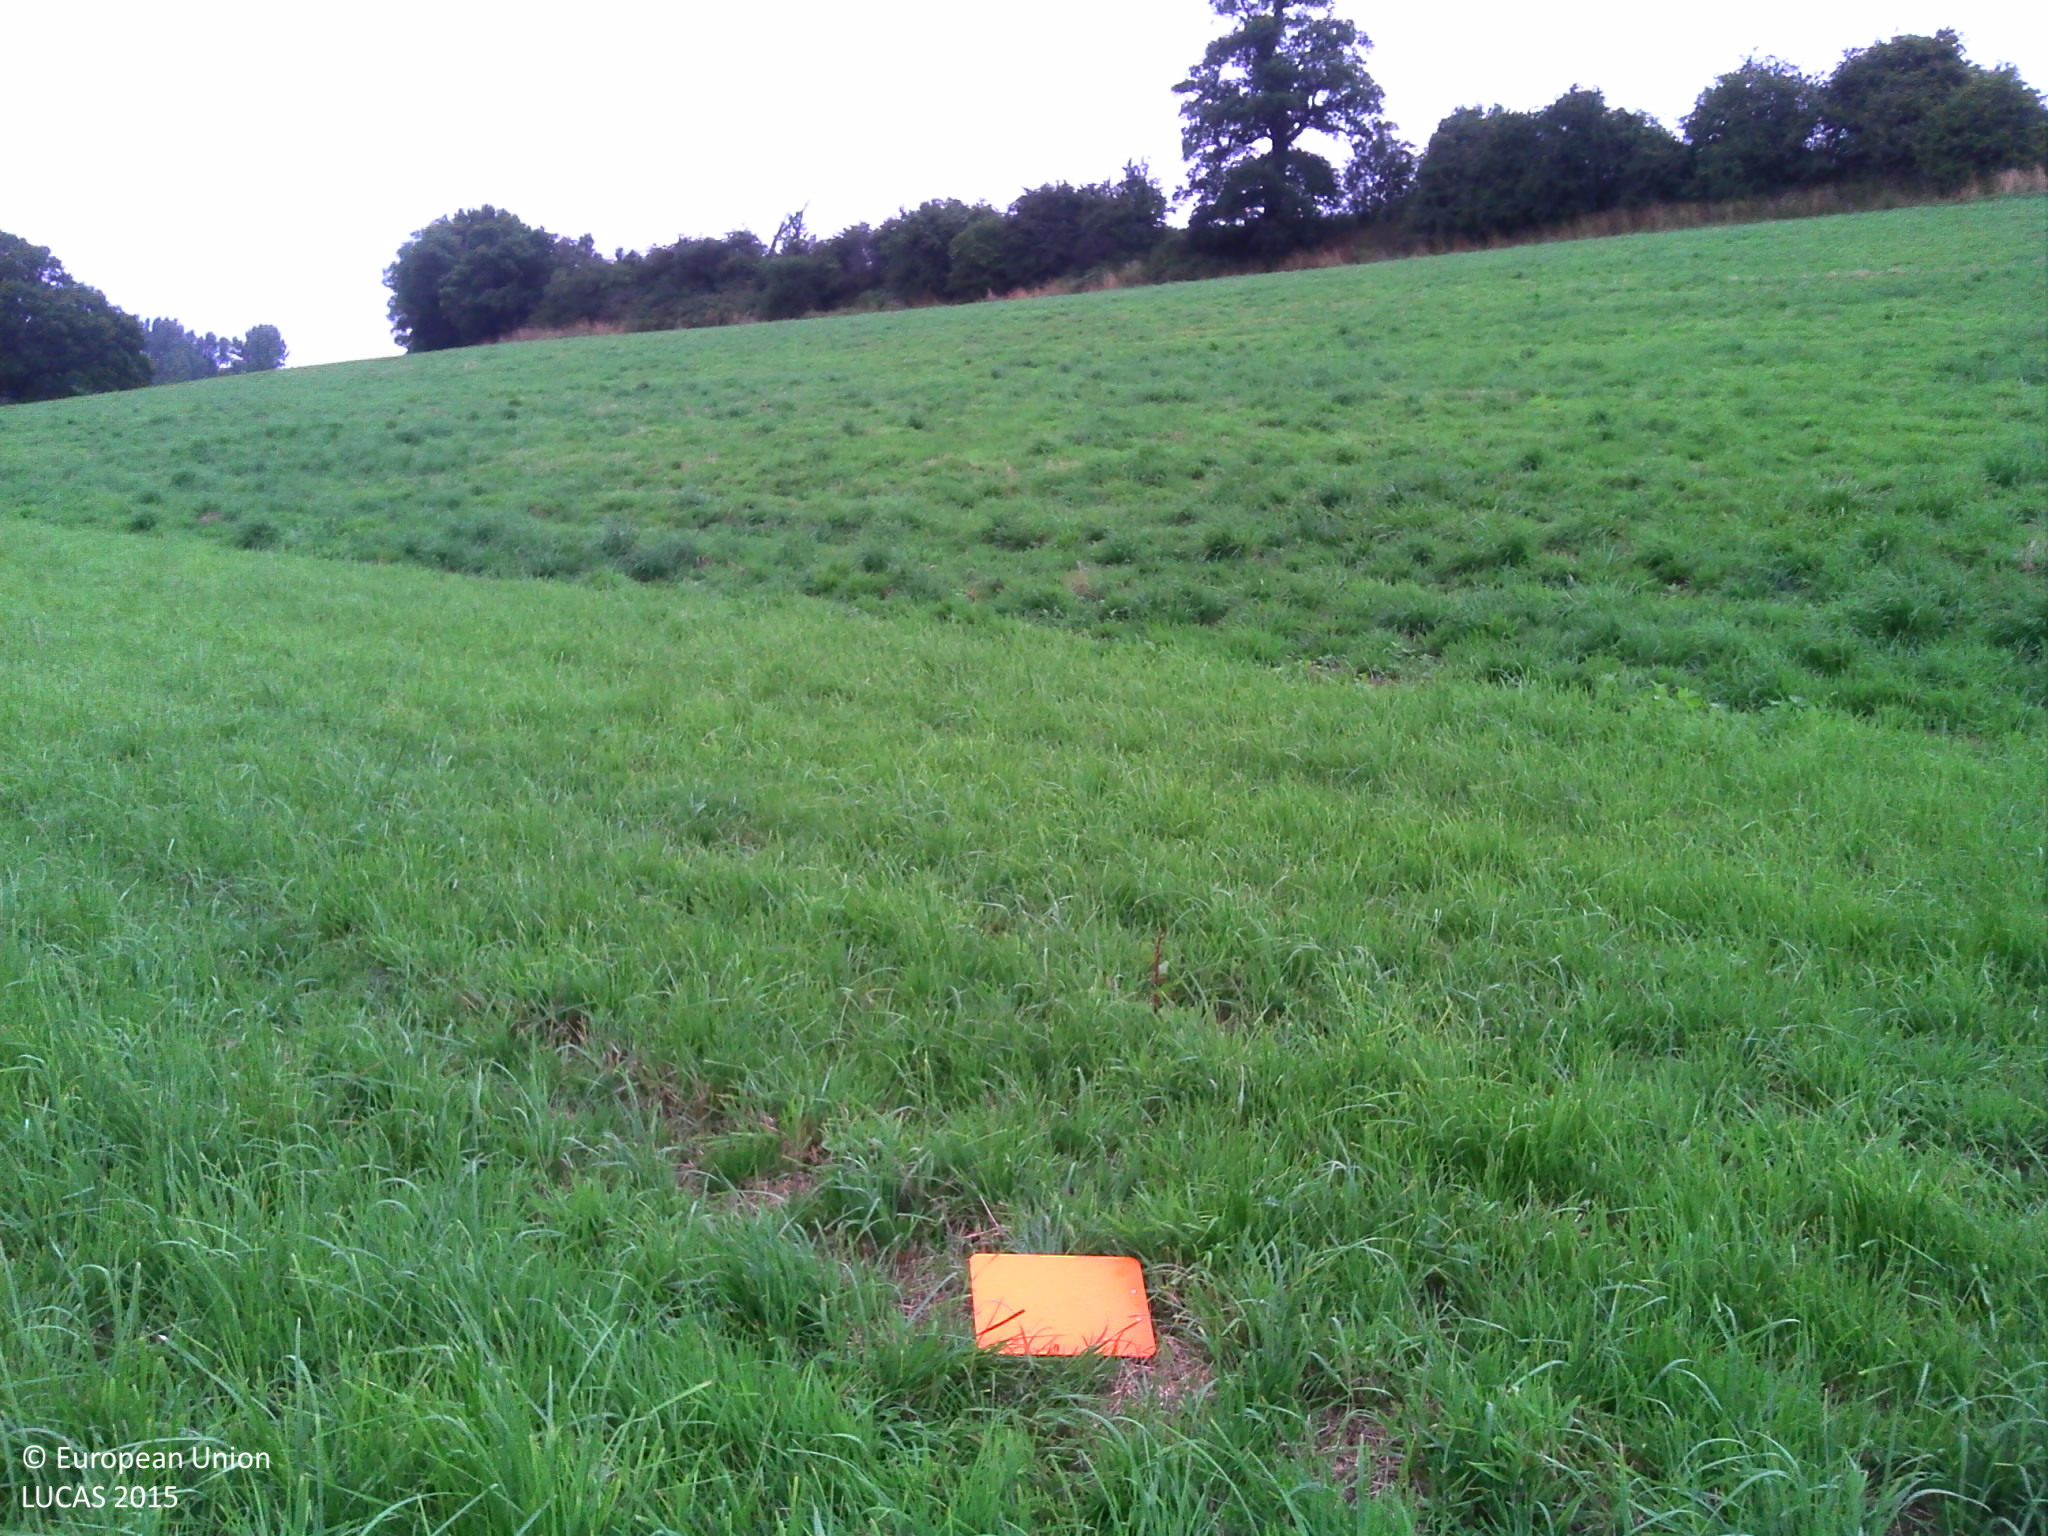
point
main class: Grassland
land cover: Grassland without tree/shrub cover
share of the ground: > 75 %
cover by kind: herbaceous plants 100 %
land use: Agriculture (excluding fallow land and kitchen gardens)
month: July
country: FR
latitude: 48.8669
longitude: -0.2713
